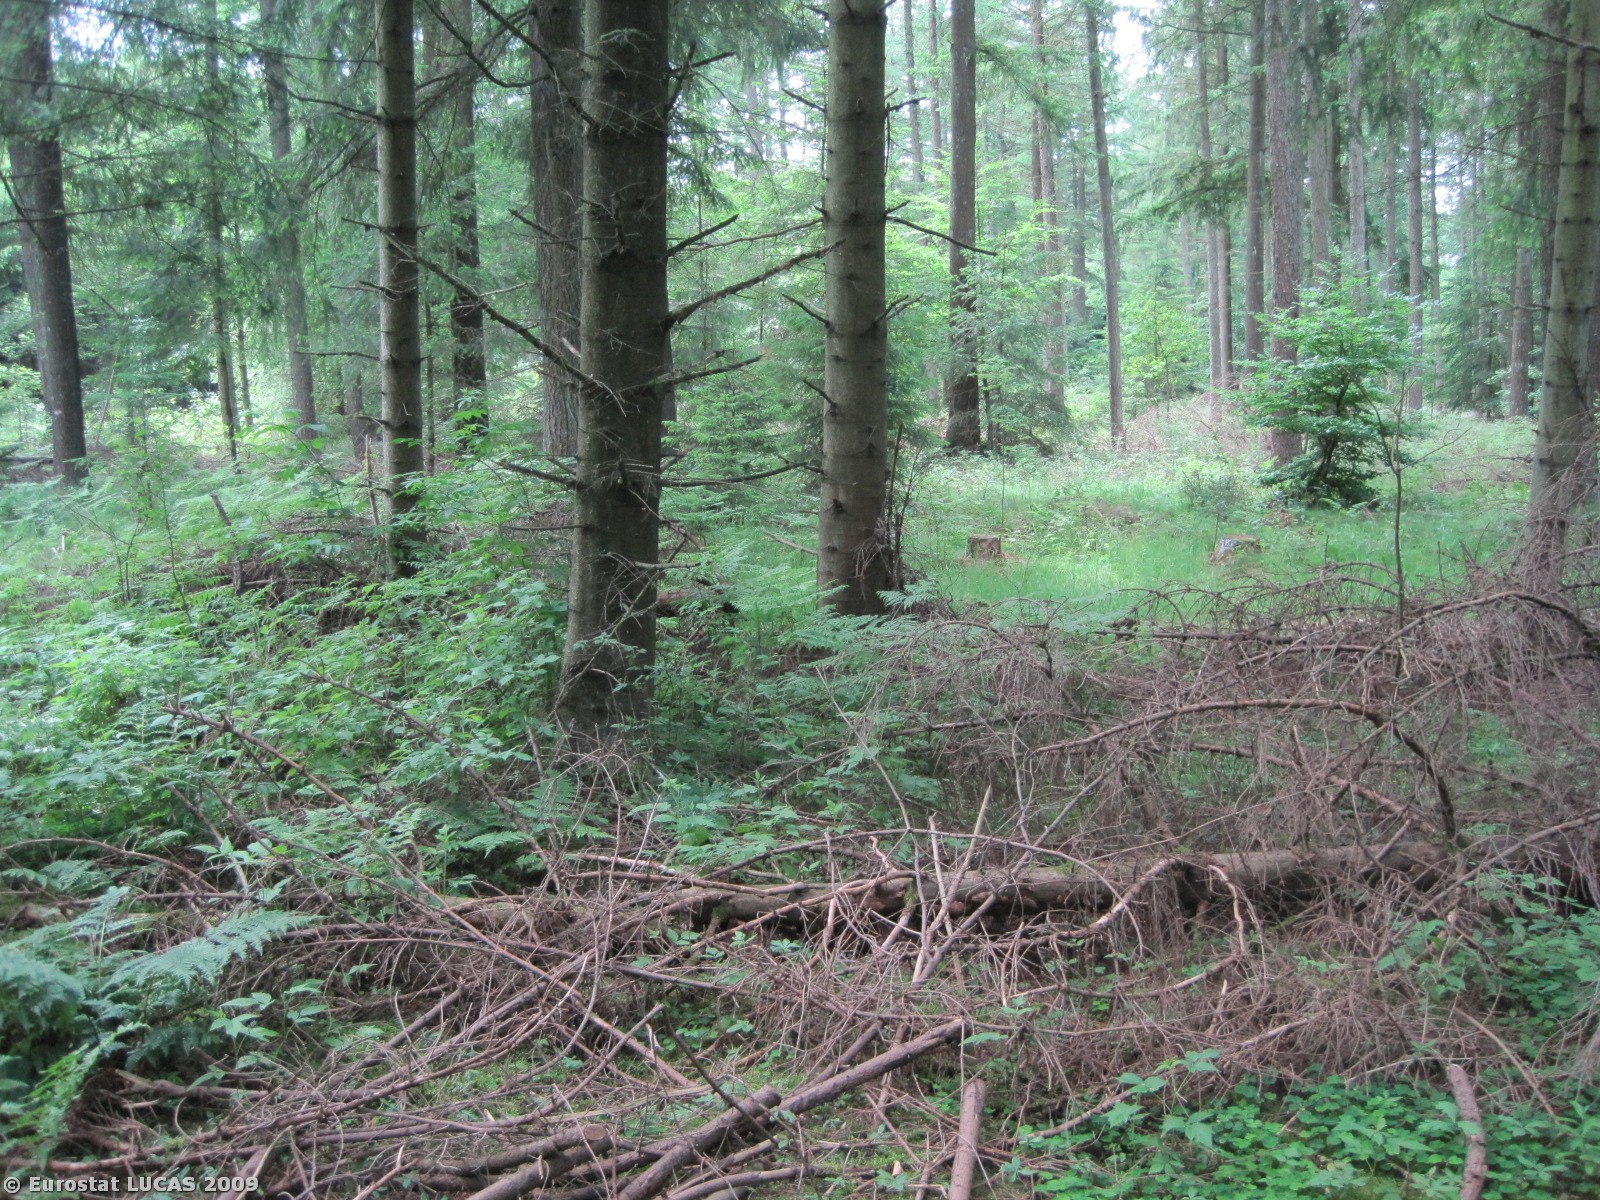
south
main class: Woodland
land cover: Coniferous woodland
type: plantations and self-sown exotic forest
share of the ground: 50 - 75 %
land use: Forestry
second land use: Amenities, museums, leisure
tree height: > 5 m
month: June
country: DK
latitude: 57.1942
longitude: 10.2478
